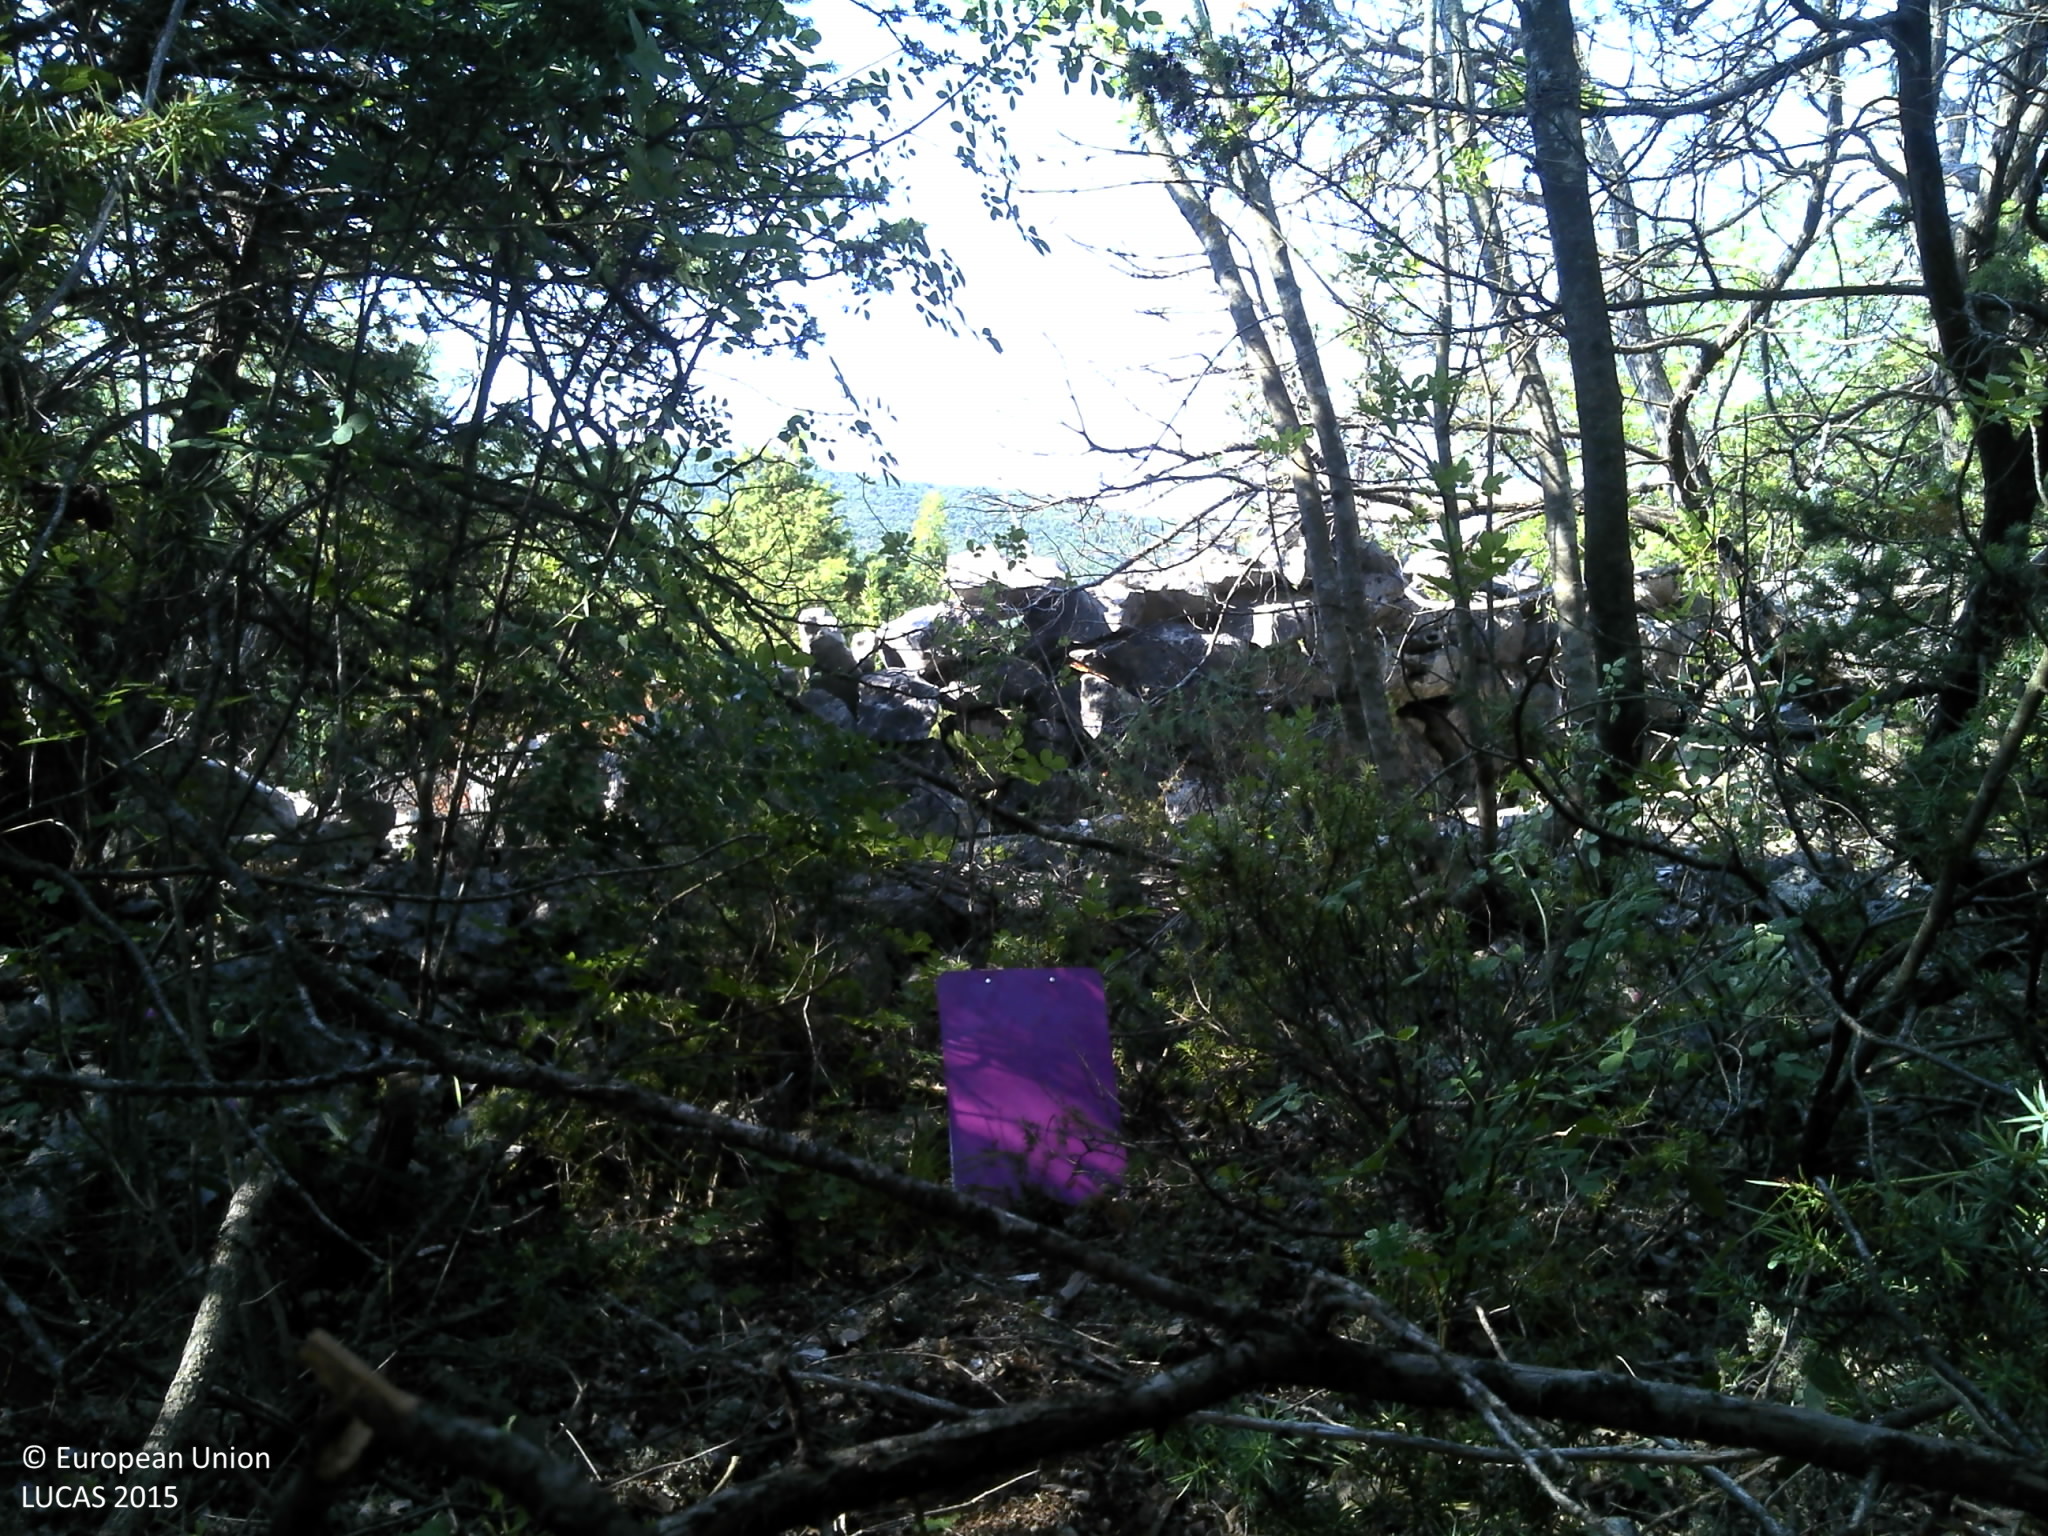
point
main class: Woodland
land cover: Pine dominated coniferous woodland
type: coniferous forest of the mediterranean region
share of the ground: > 75 %
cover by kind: coniferous forest trees 75 %, unconsolidated bare surface 15 %, broadleaved forest trees 5 %, shrubs 5 %
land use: Semi-natural and natural areas not in use
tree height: > 5 m
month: June
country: HR
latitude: 43.5686
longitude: 16.1938
